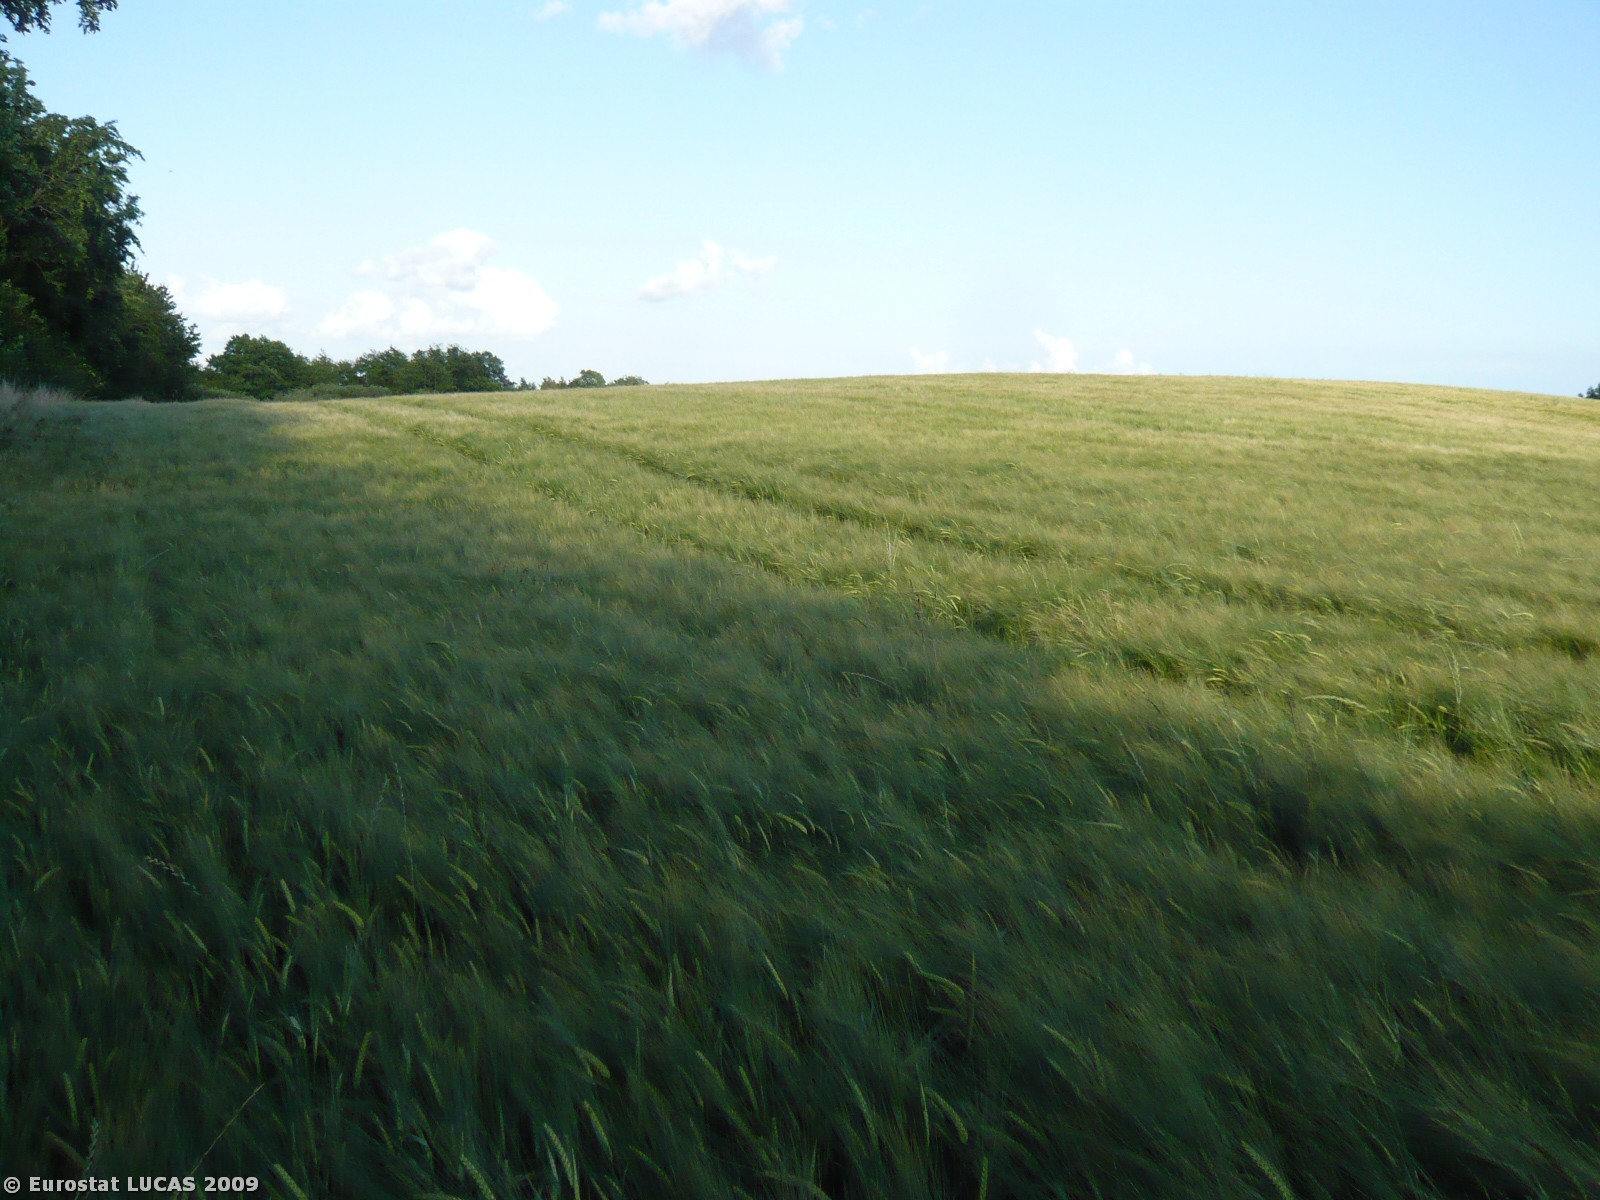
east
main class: Woodland
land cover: Broadleaved woodland
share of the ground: > 75 %
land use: Residential
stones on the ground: < 10 %
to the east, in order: Broadleaved woodland; Barley; Tracks; Inland water bodies; Inland marshes; Broadleaved woodland
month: July
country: DK
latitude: 55.5691
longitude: 11.3784
